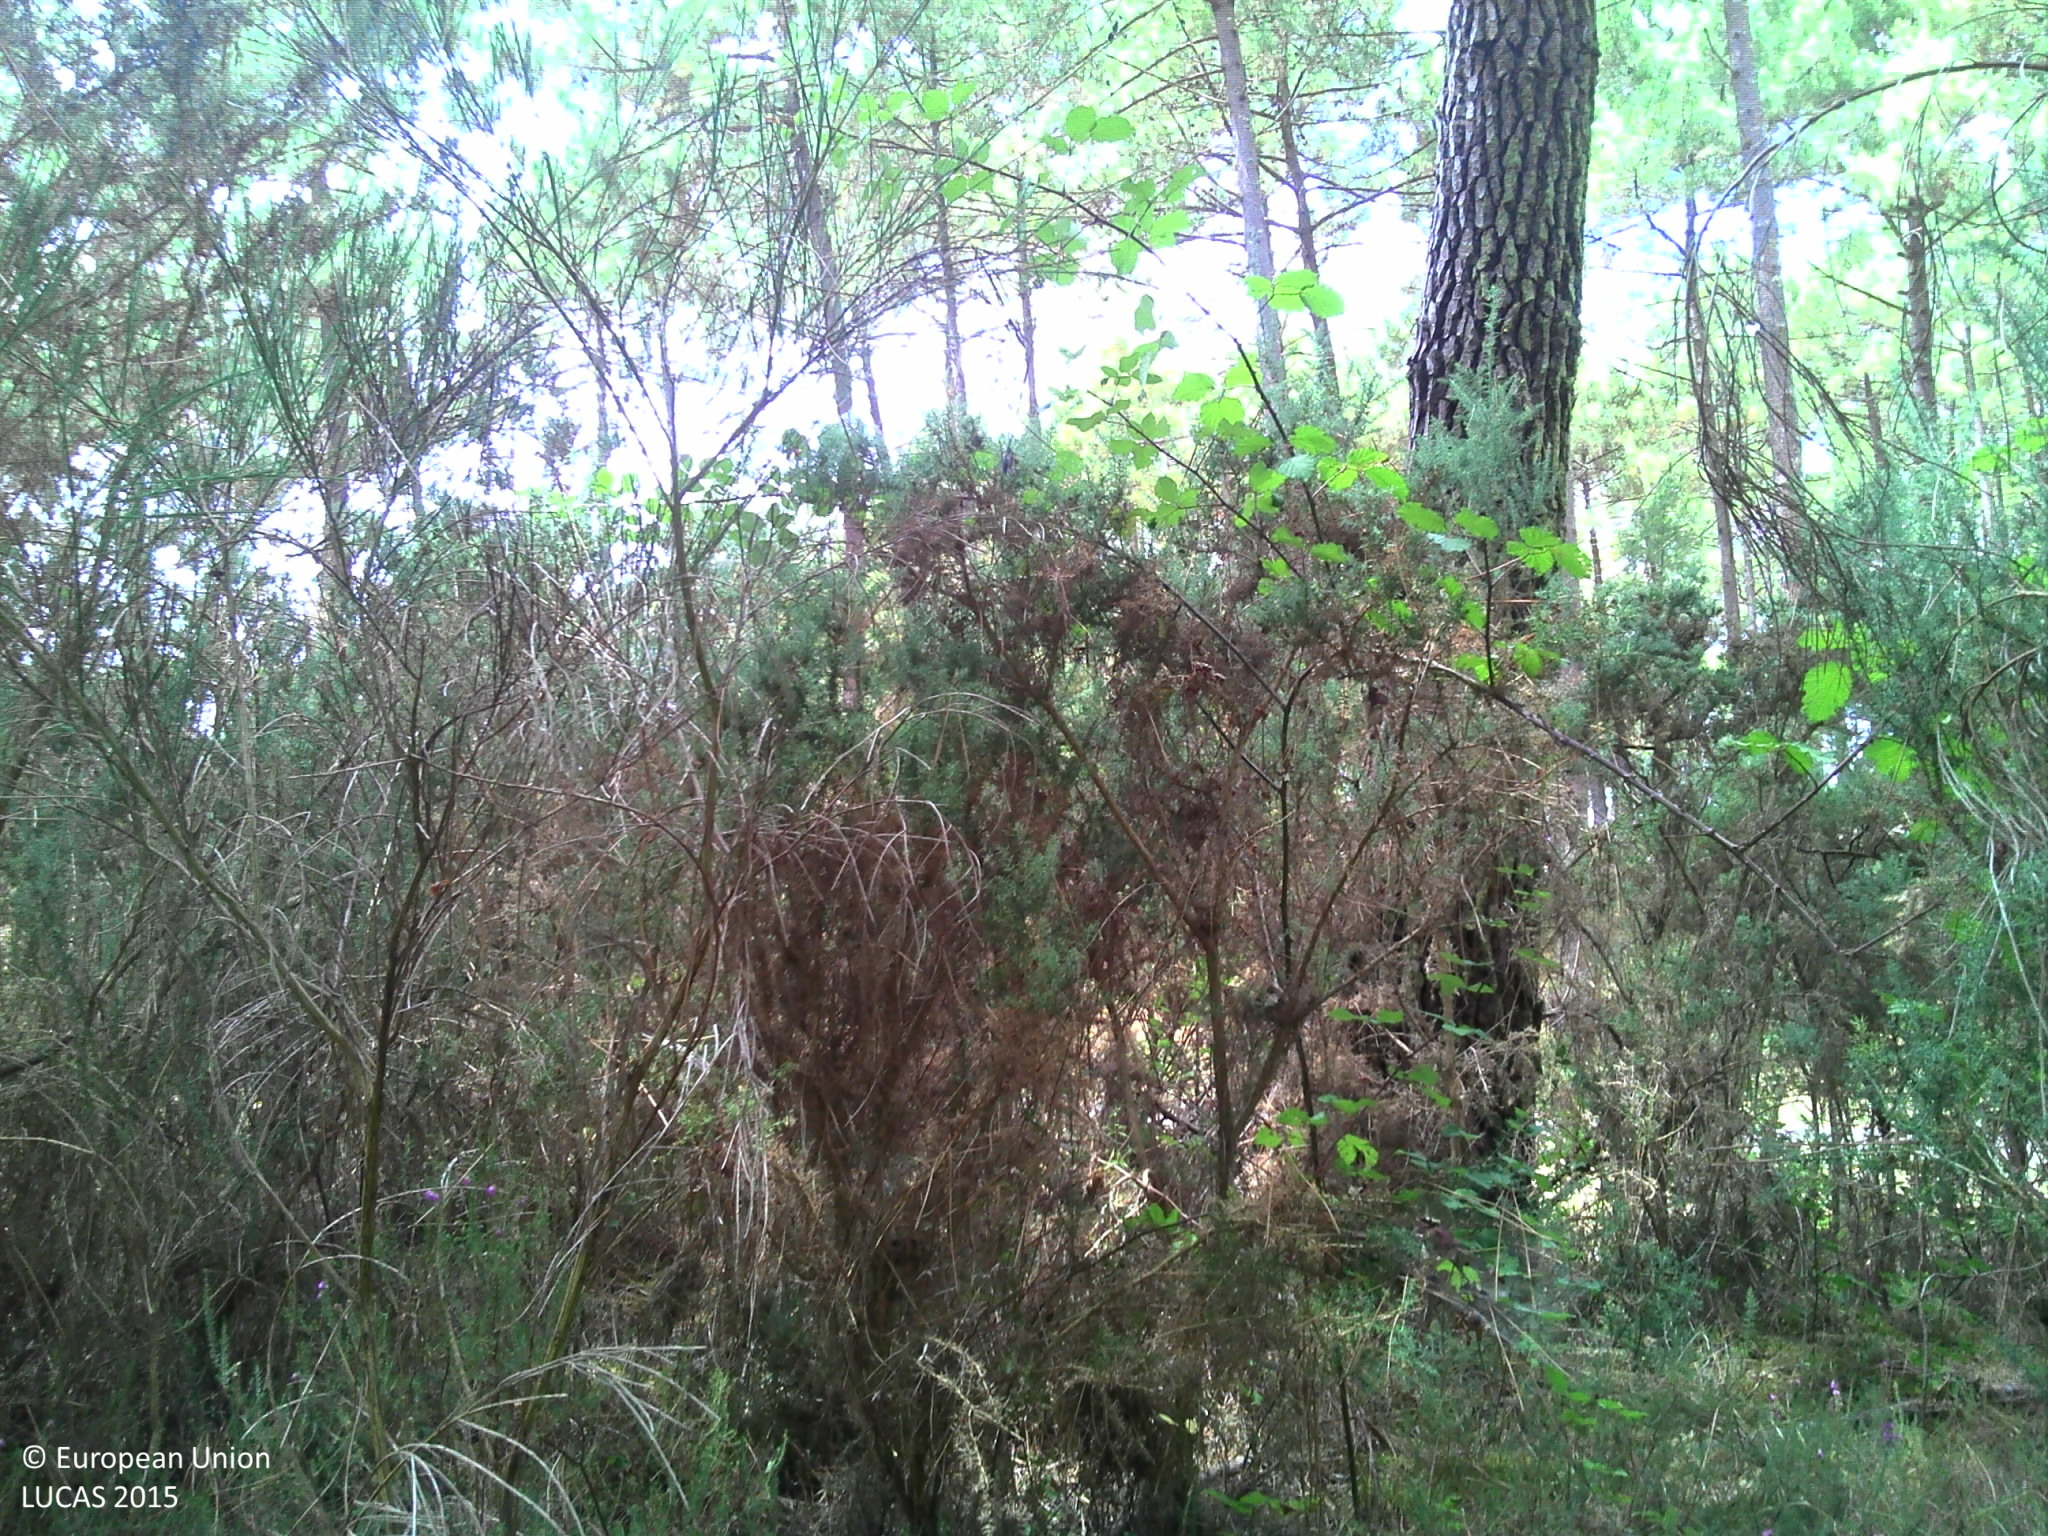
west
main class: Woodland
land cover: Pine dominated coniferous woodland
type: coniferous forest of the mediterranean region
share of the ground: > 75 %
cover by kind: coniferous forest trees 80 %, herbaceous plants 10 %, lichens and mosses 10 %
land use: Forestry
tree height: > 5 m
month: July
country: FR
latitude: 44.1691
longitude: -1.2896
